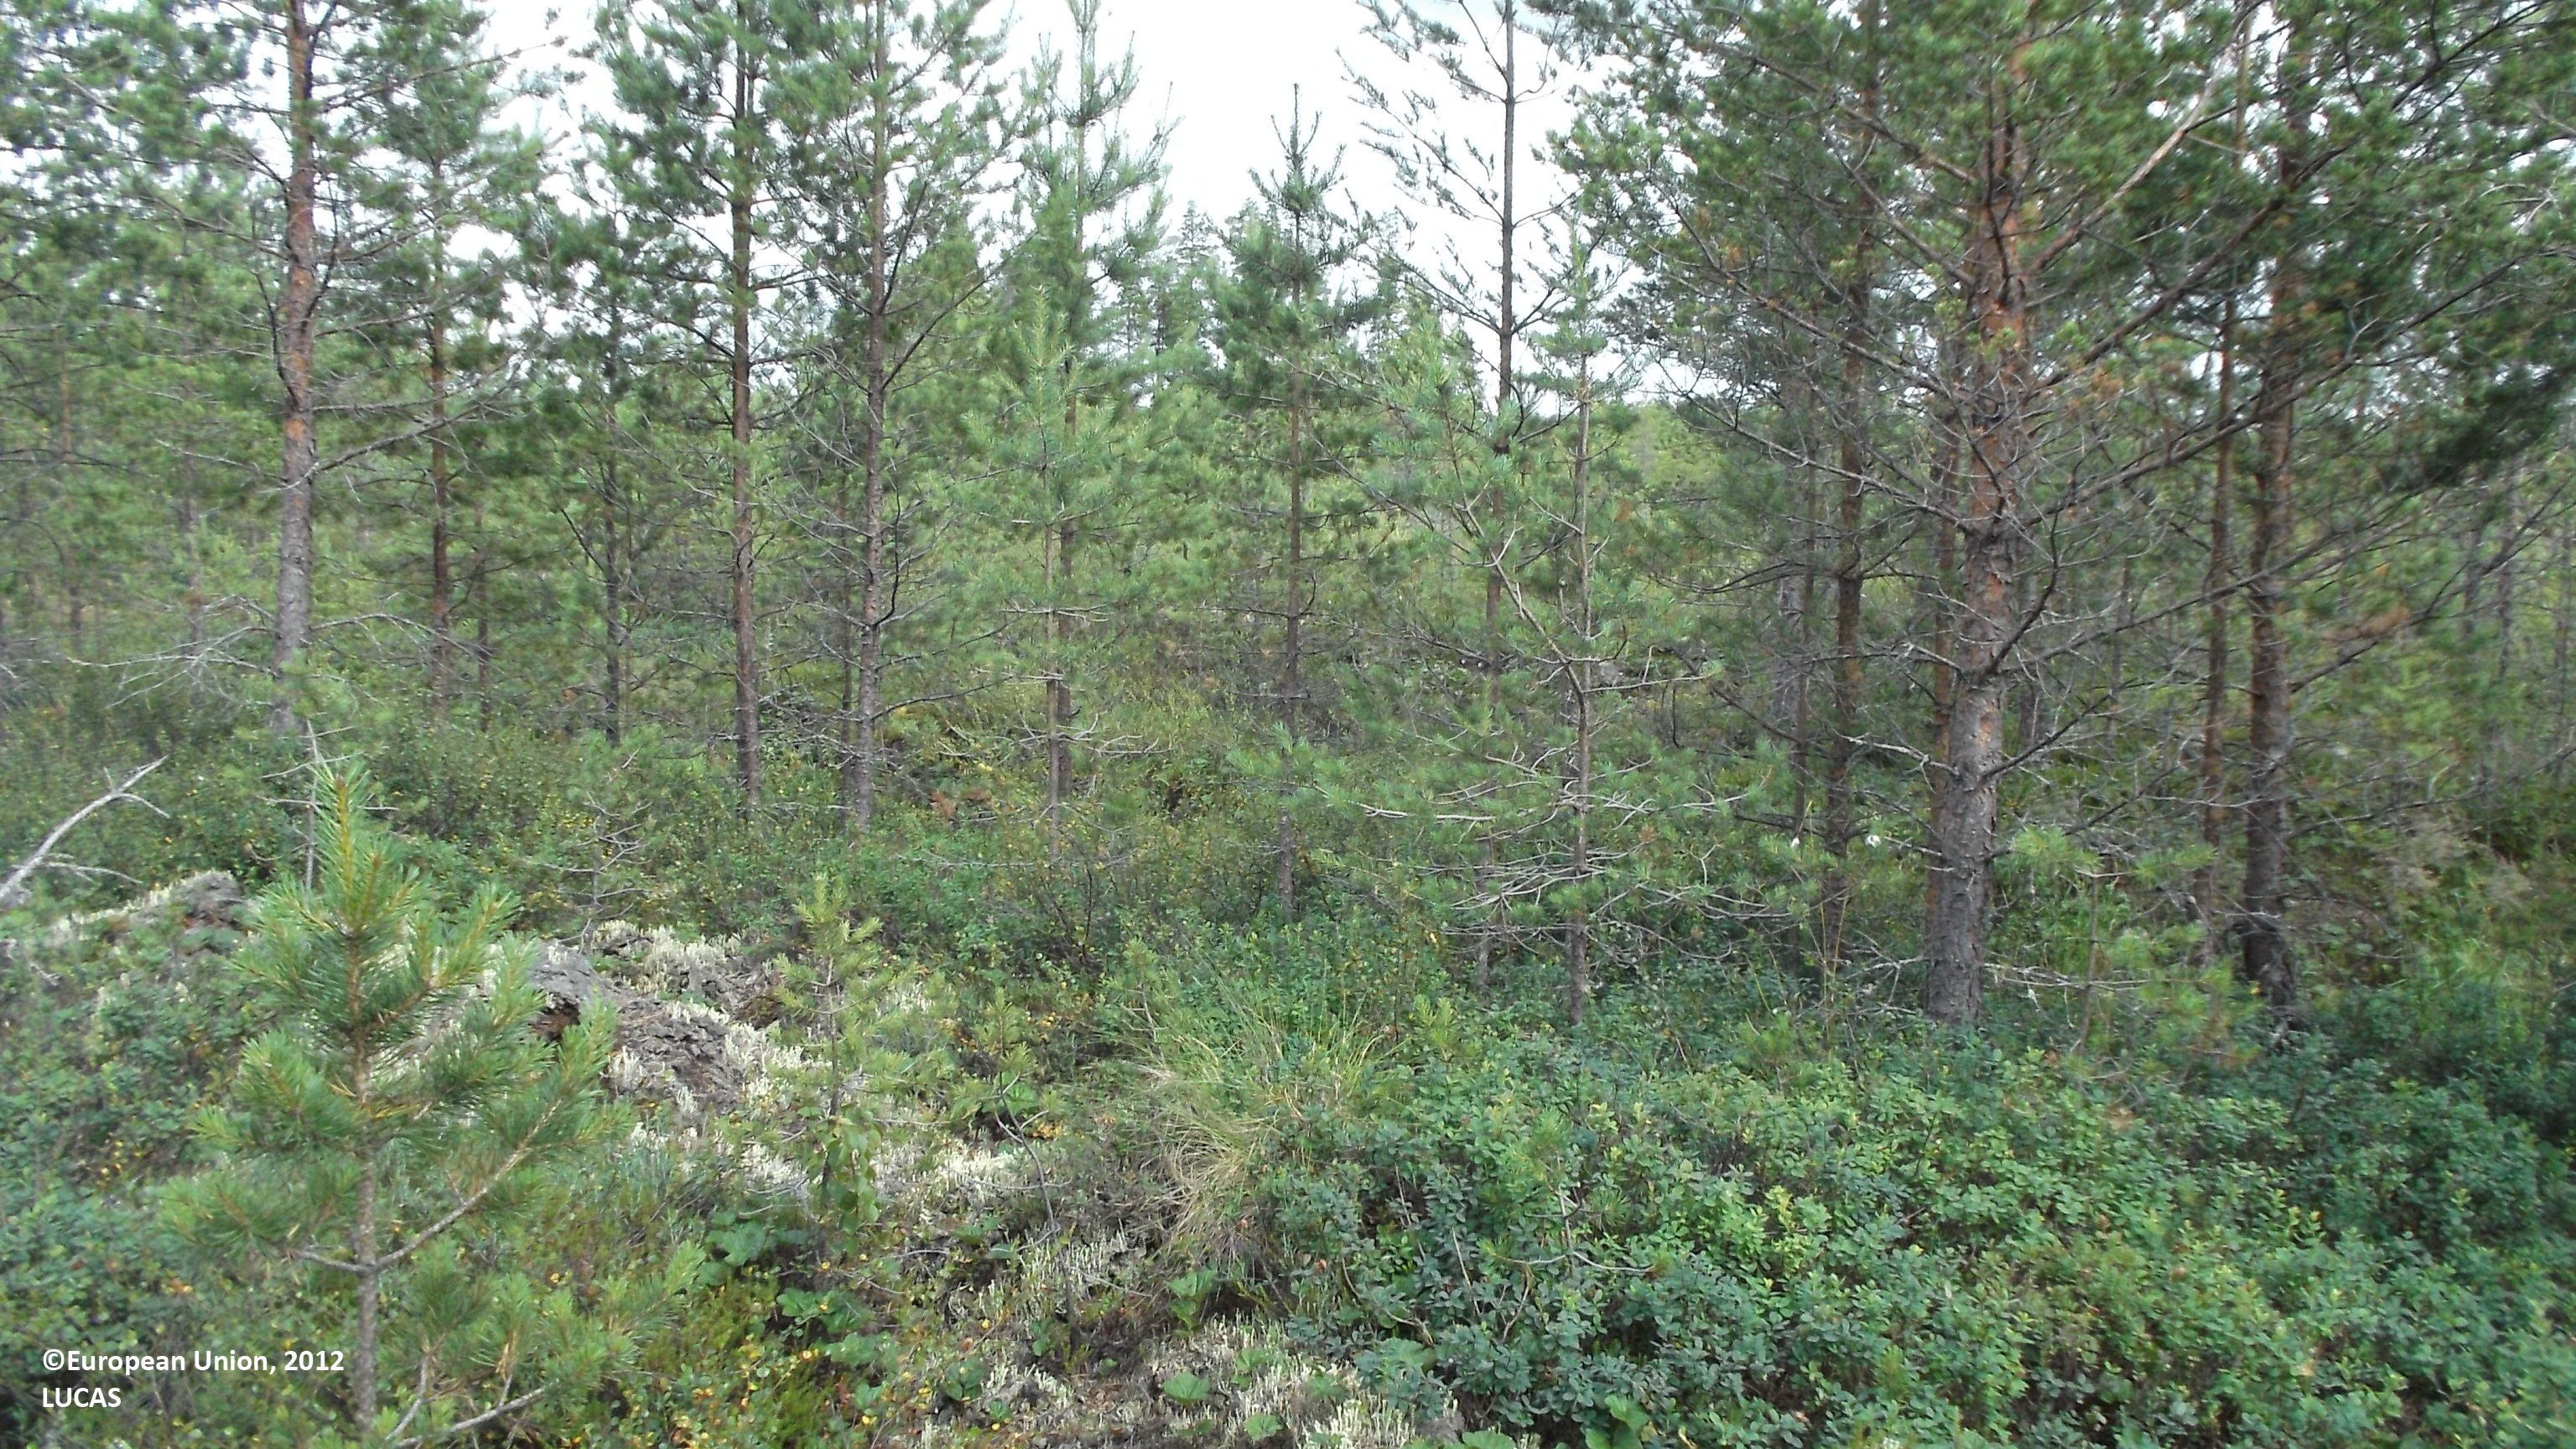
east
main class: Woodland
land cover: Pine dominated coniferous woodland
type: mire and swamp forests
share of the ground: 25 - 50 %
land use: Forestry
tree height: > 5 m
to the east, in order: Pine dominated coniferous woodland; Ditches and canals; Pine dominated coniferous woodland; Peatbogs; Ditches and canals; Pine dominated coniferous woodland; Broadleaved woodland; Ditches and canals; Other mixed woodland
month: July
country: FI
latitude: 63.5823
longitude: 23.2527
